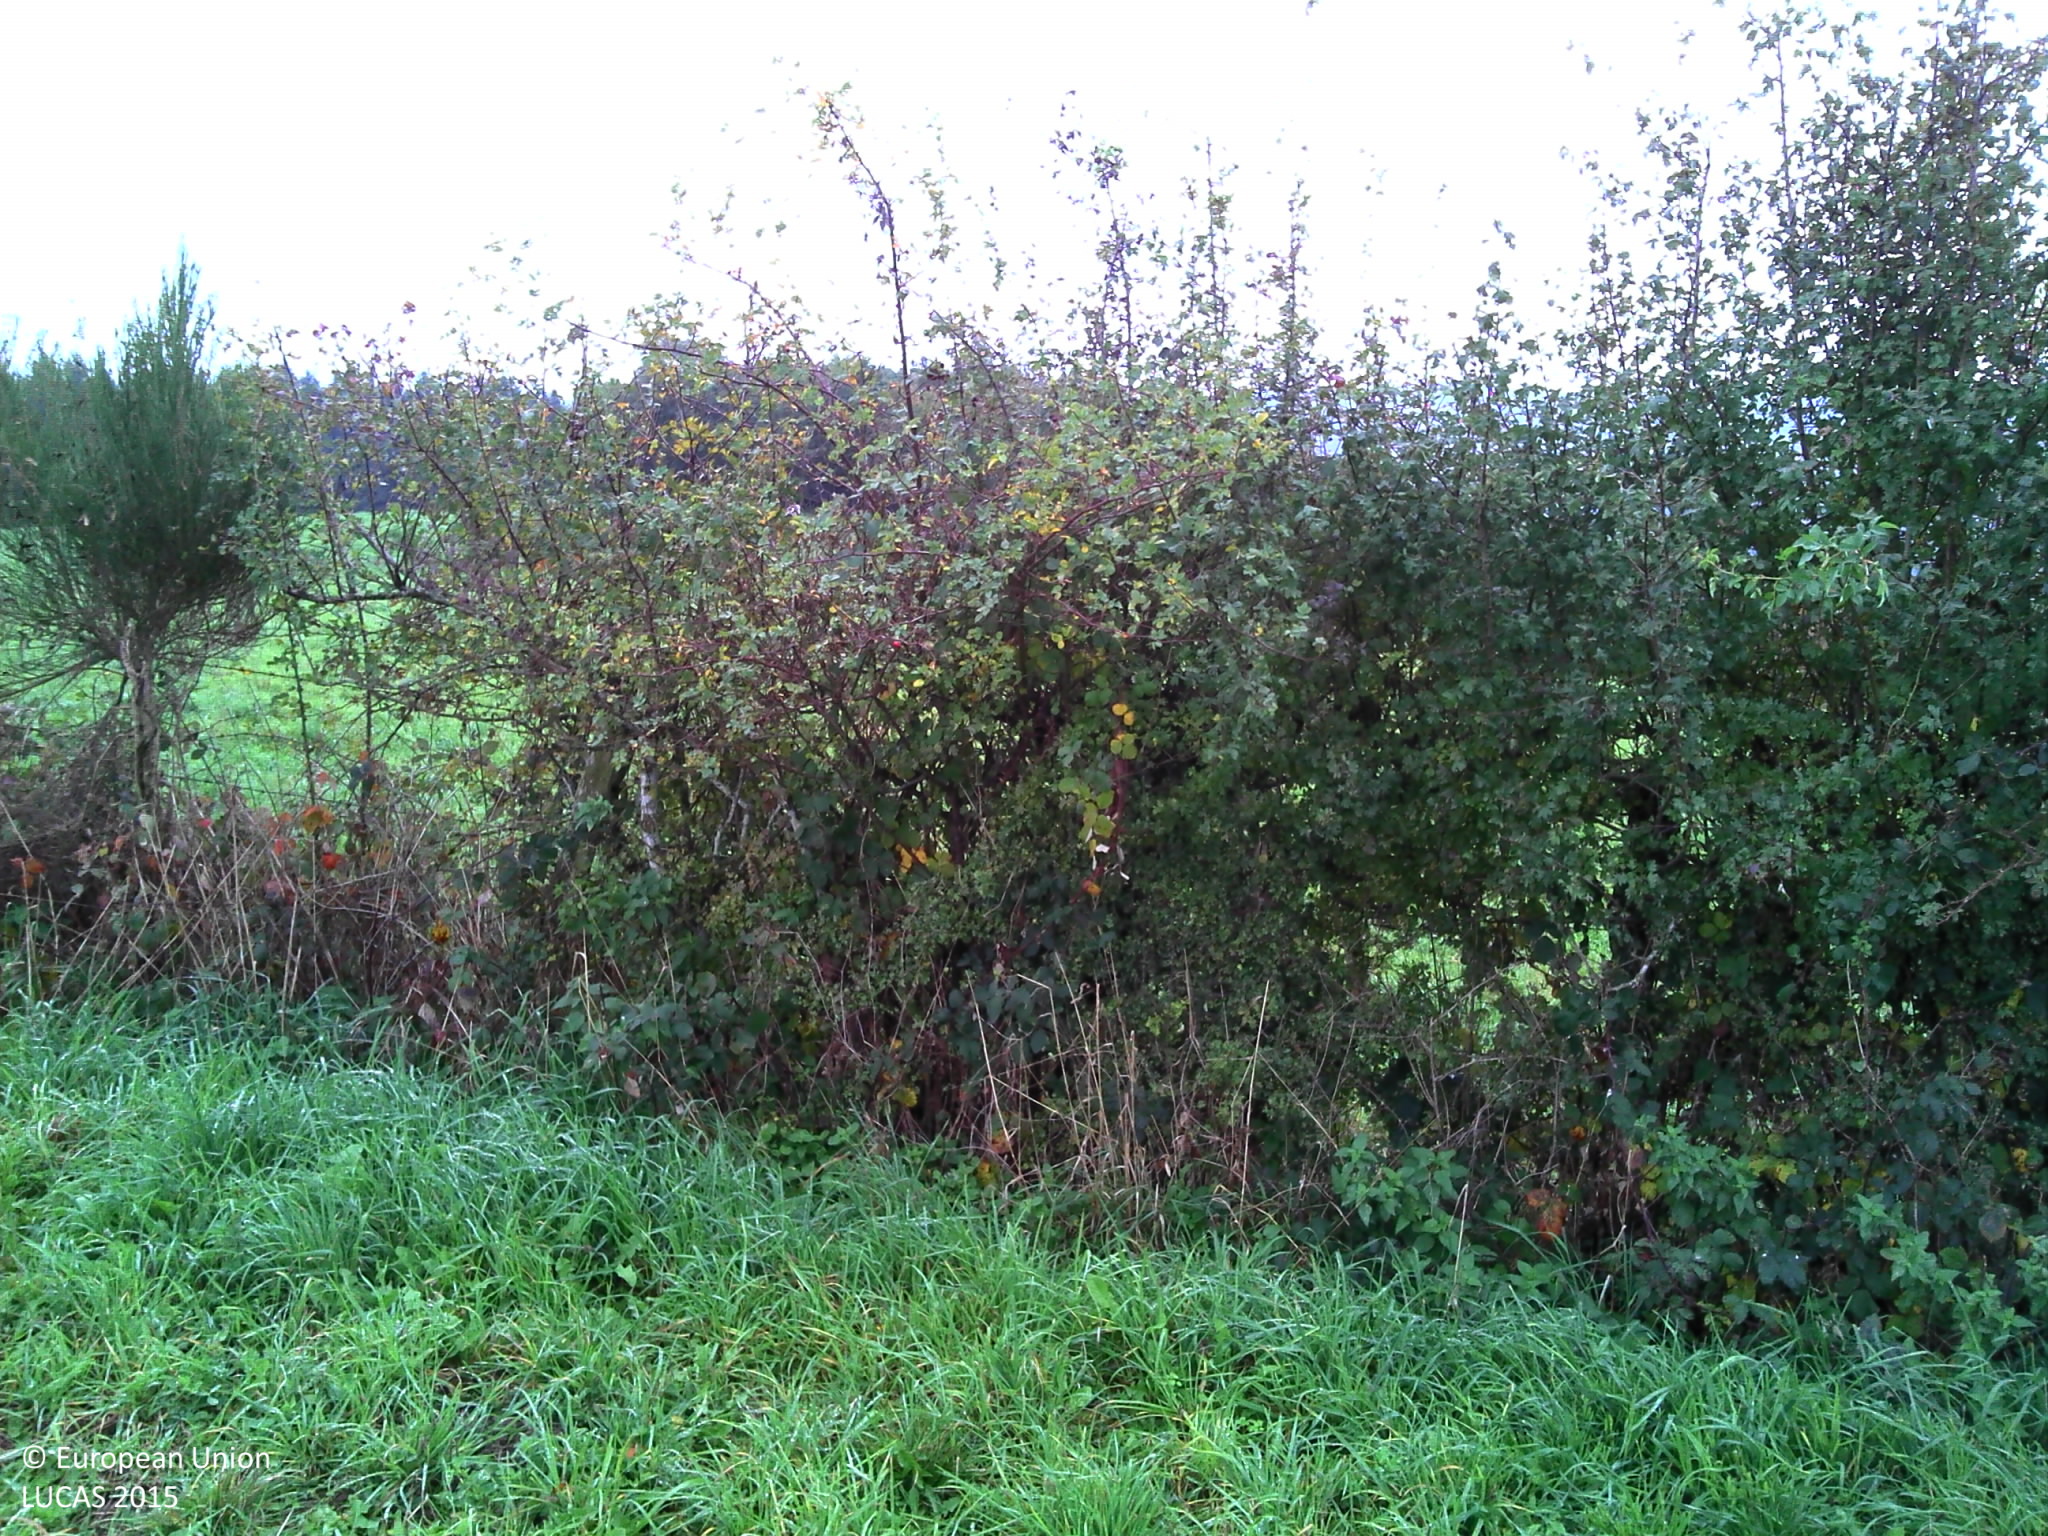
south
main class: Grassland
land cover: Grassland without tree/shrub cover
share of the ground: > 75 %
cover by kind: herbaceous plants 100 %
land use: Agriculture (excluding fallow land and kitchen gardens)
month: October
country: FR
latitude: 45.9859
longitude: 2.8595
